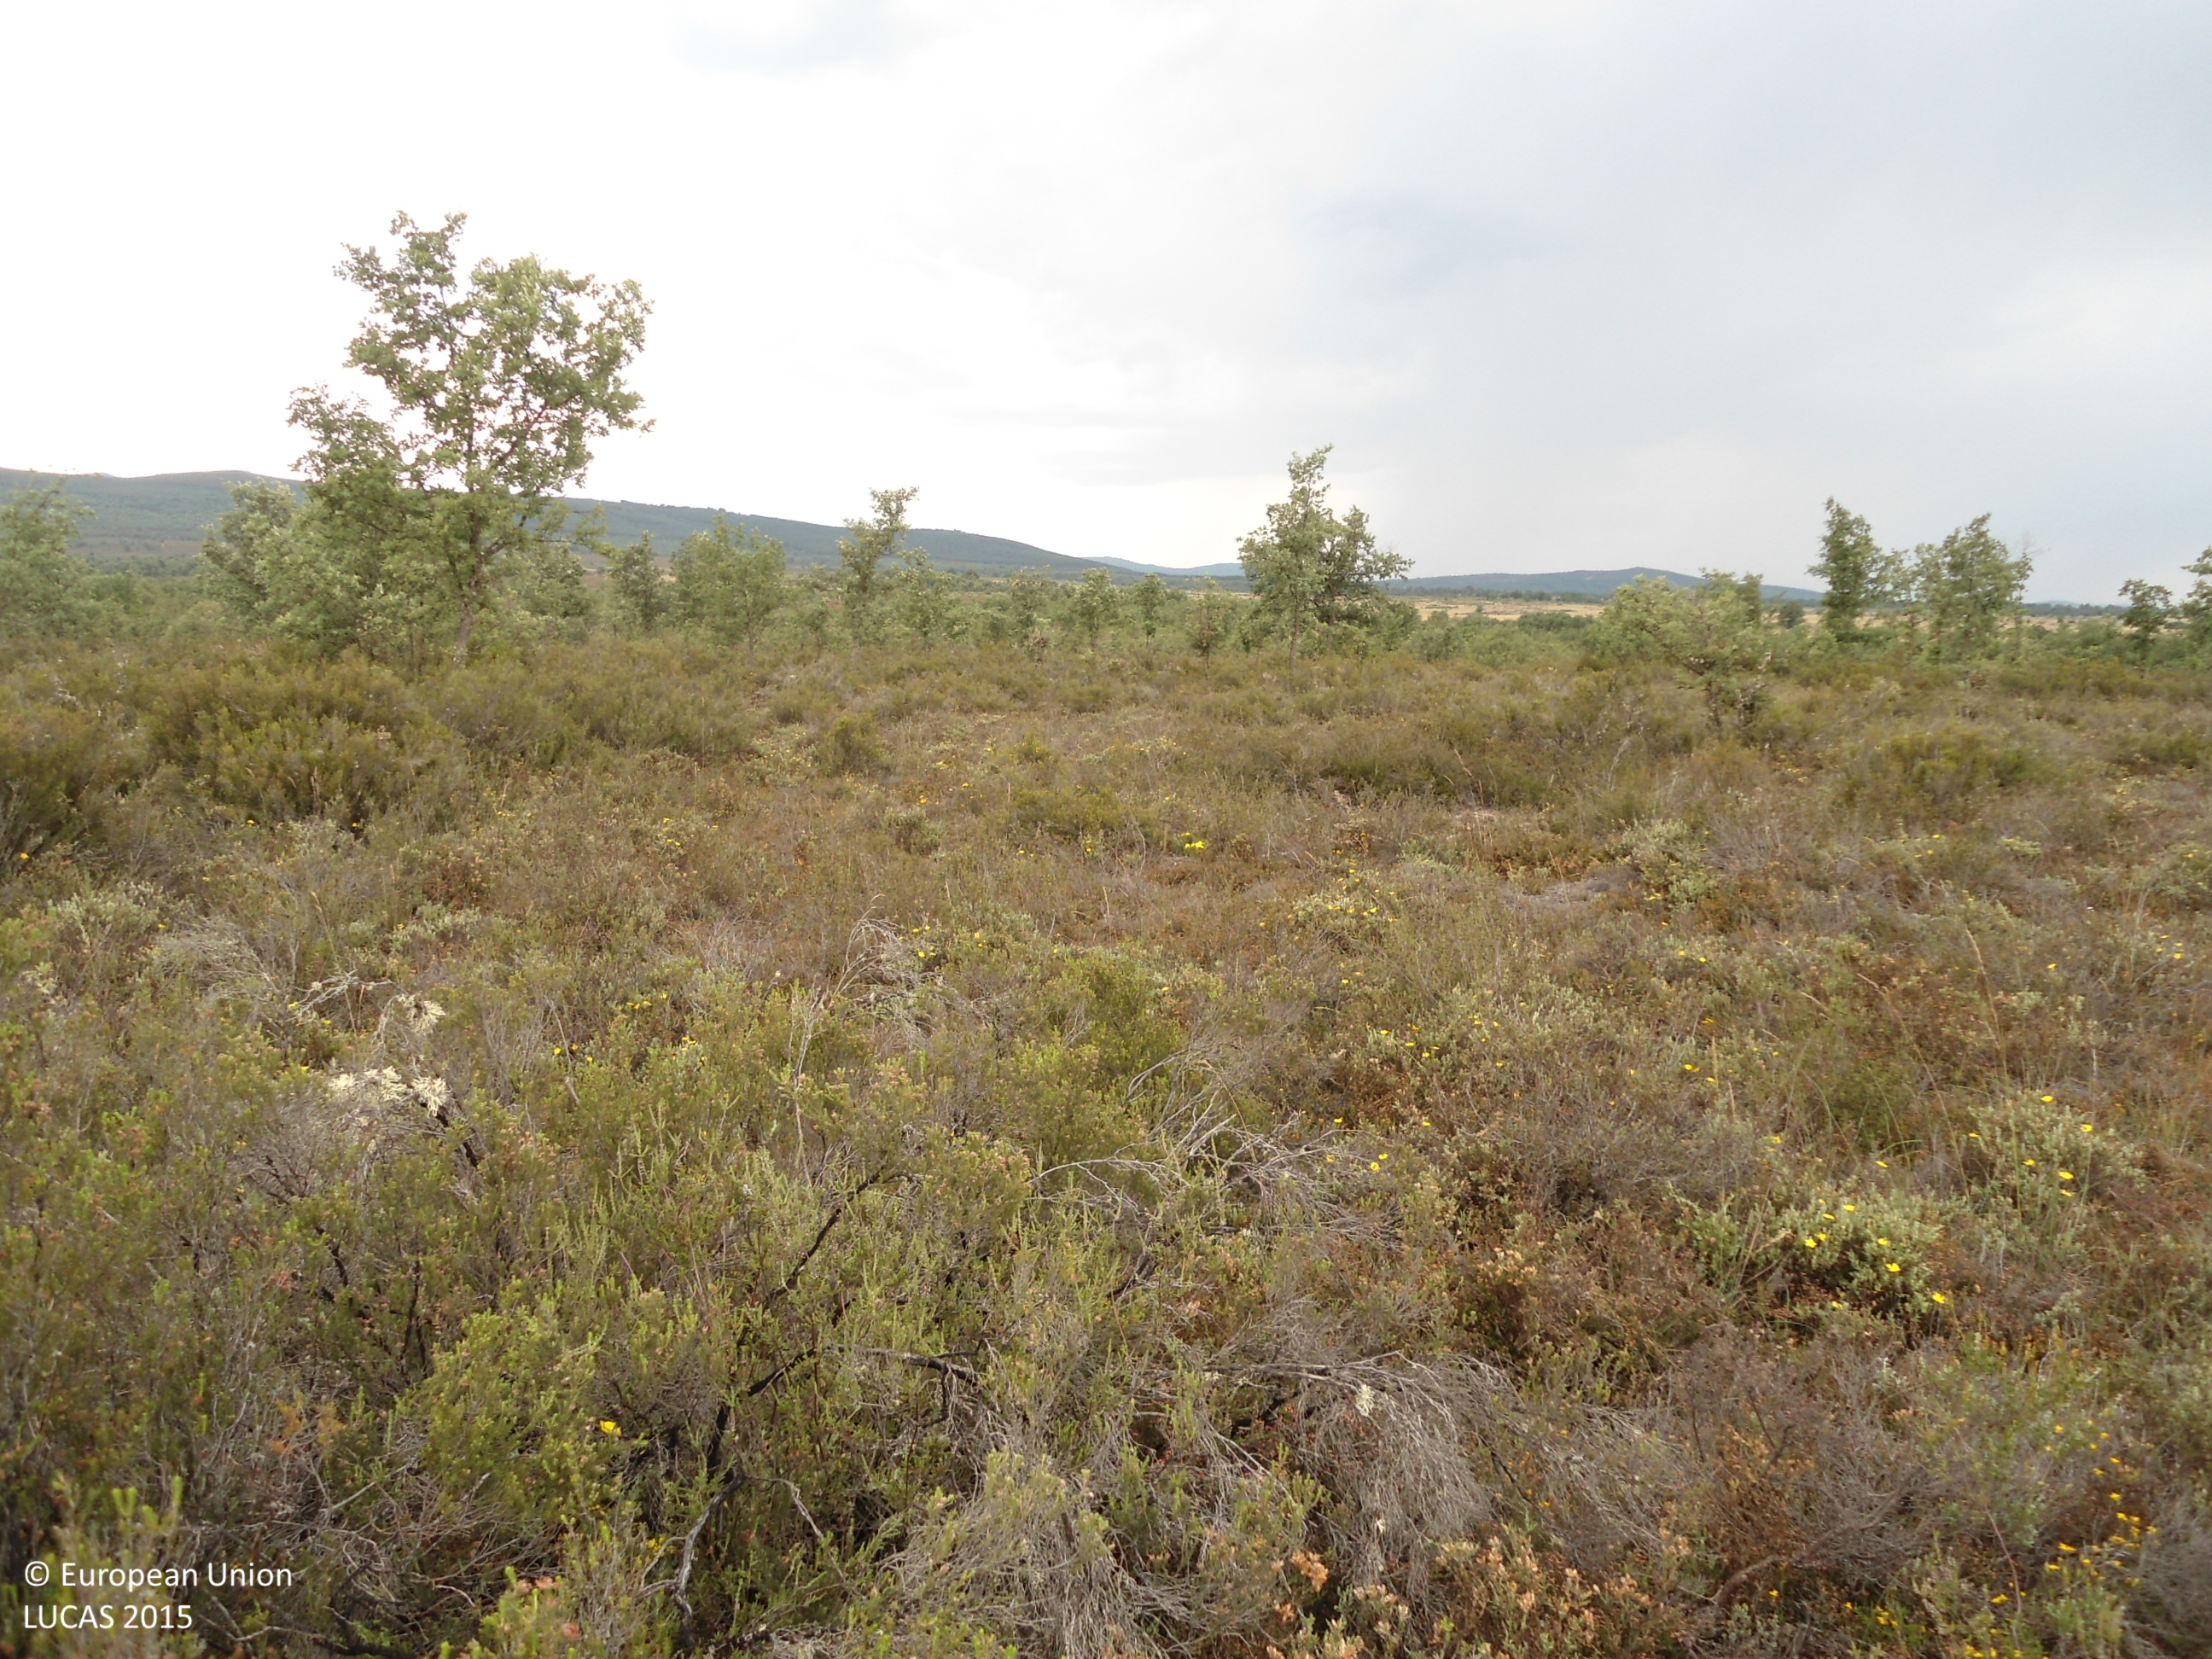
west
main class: Shrubland
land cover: Shrubland with sparse tree cover
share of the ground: > 75 %
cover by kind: shrubs 95 %, broadleaved forest trees 5 %
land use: Semi-natural and natural areas not in use
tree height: < 5 m
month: June
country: ES
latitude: 41.9455
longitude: -6.2058
